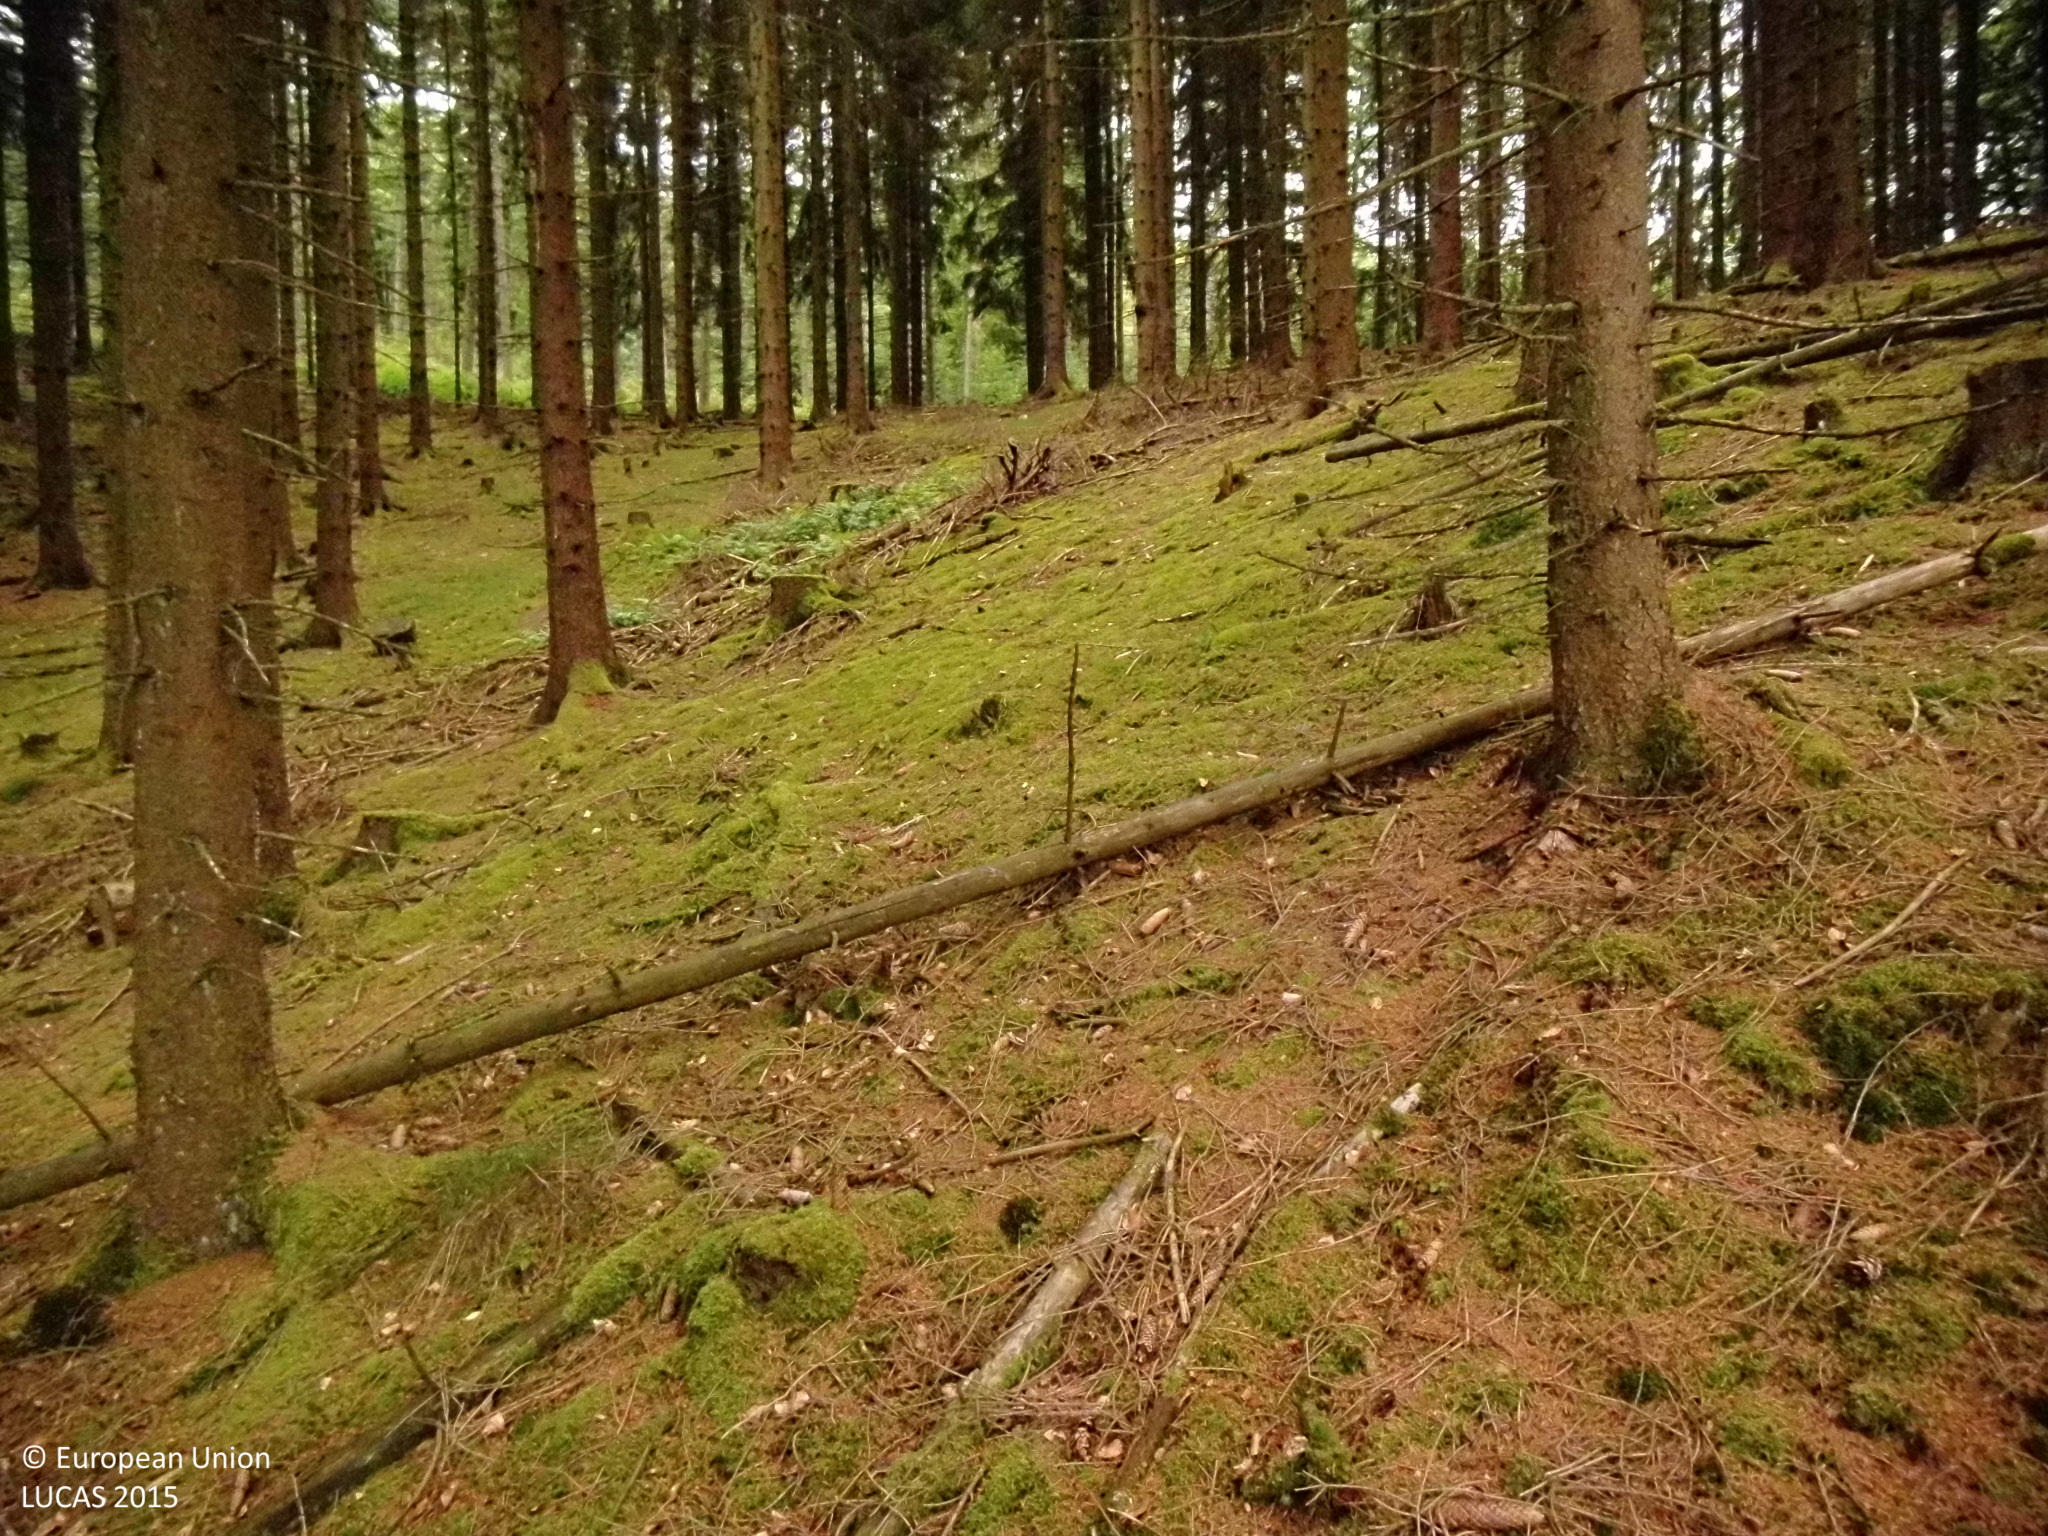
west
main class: Woodland
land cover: Spruce dominated coniferous woodland
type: hemiboreal forest and nemoral coniferous forest and mixed broadleaved-coniferous forest
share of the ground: > 75 %
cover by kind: coniferous forest trees 85 %, lichens and mosses 10 %, unconsolidated bare surface 5 %
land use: Forestry
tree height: > 5 m
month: July
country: DE
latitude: 50.7603
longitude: 8.0015
